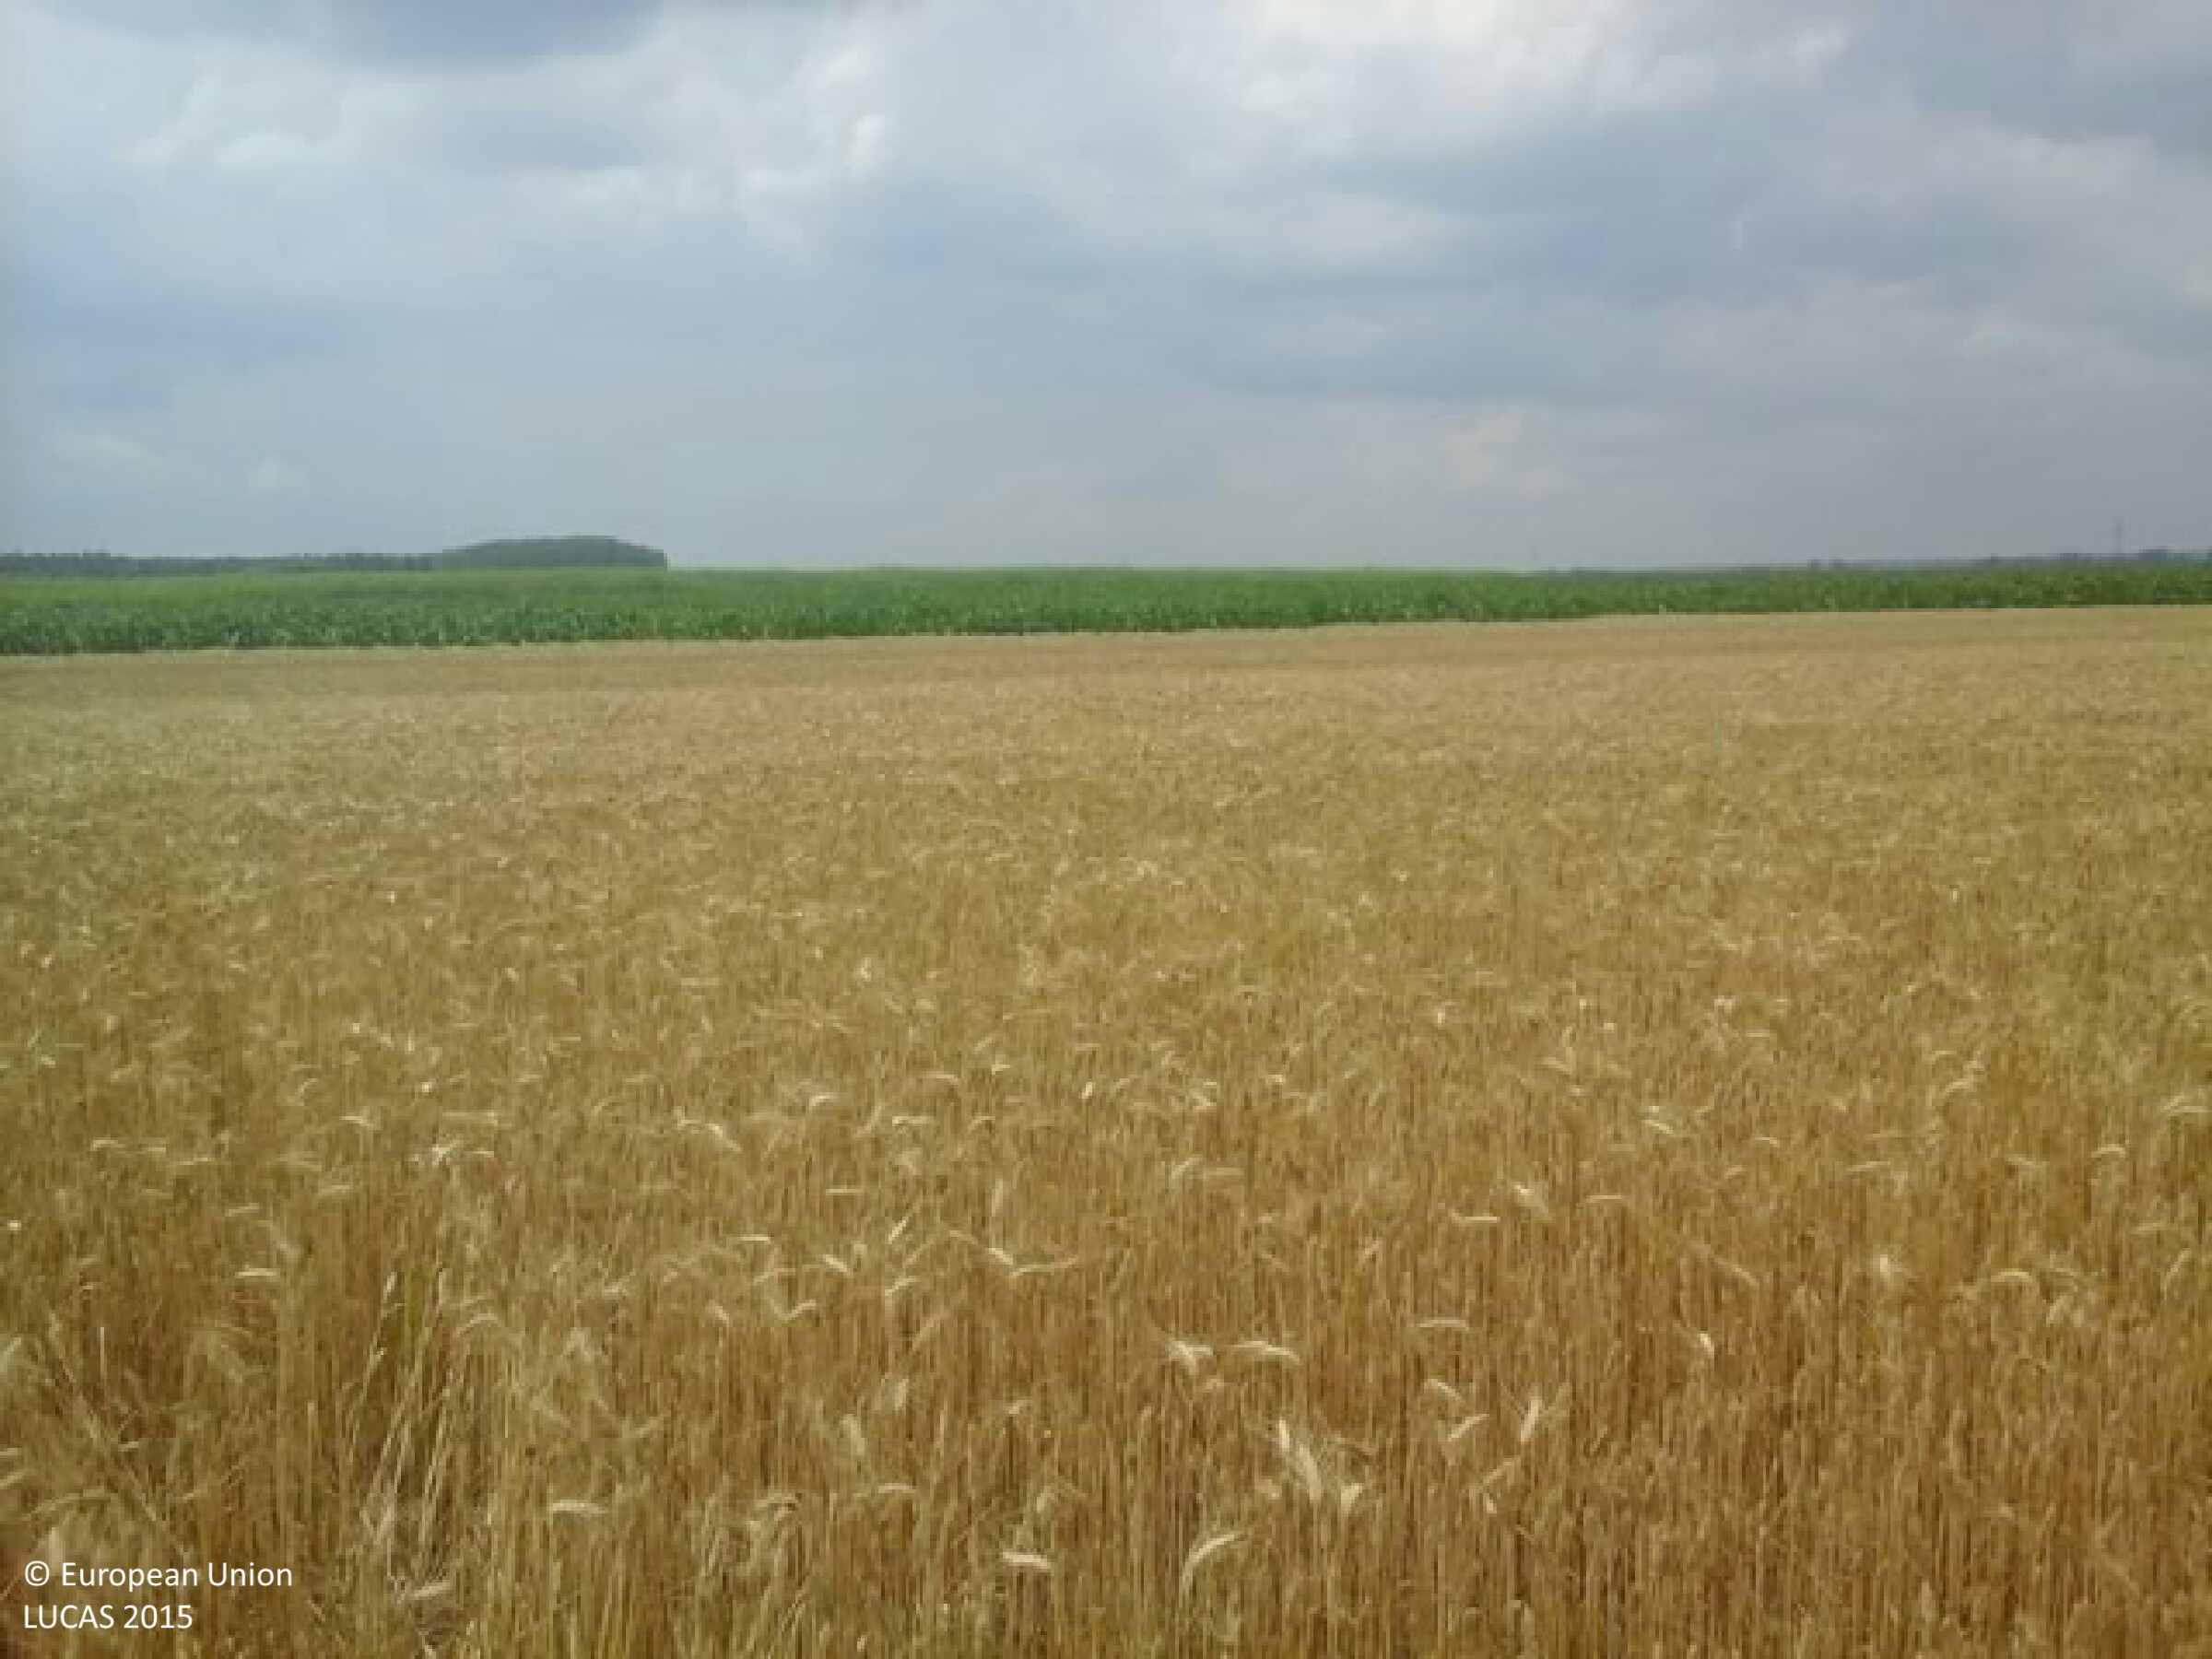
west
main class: Cropland
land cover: Common wheat
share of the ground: > 75 %
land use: Agriculture (excluding fallow land and kitchen gardens)
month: June
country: HU
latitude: 46.0729
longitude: 18.8677
